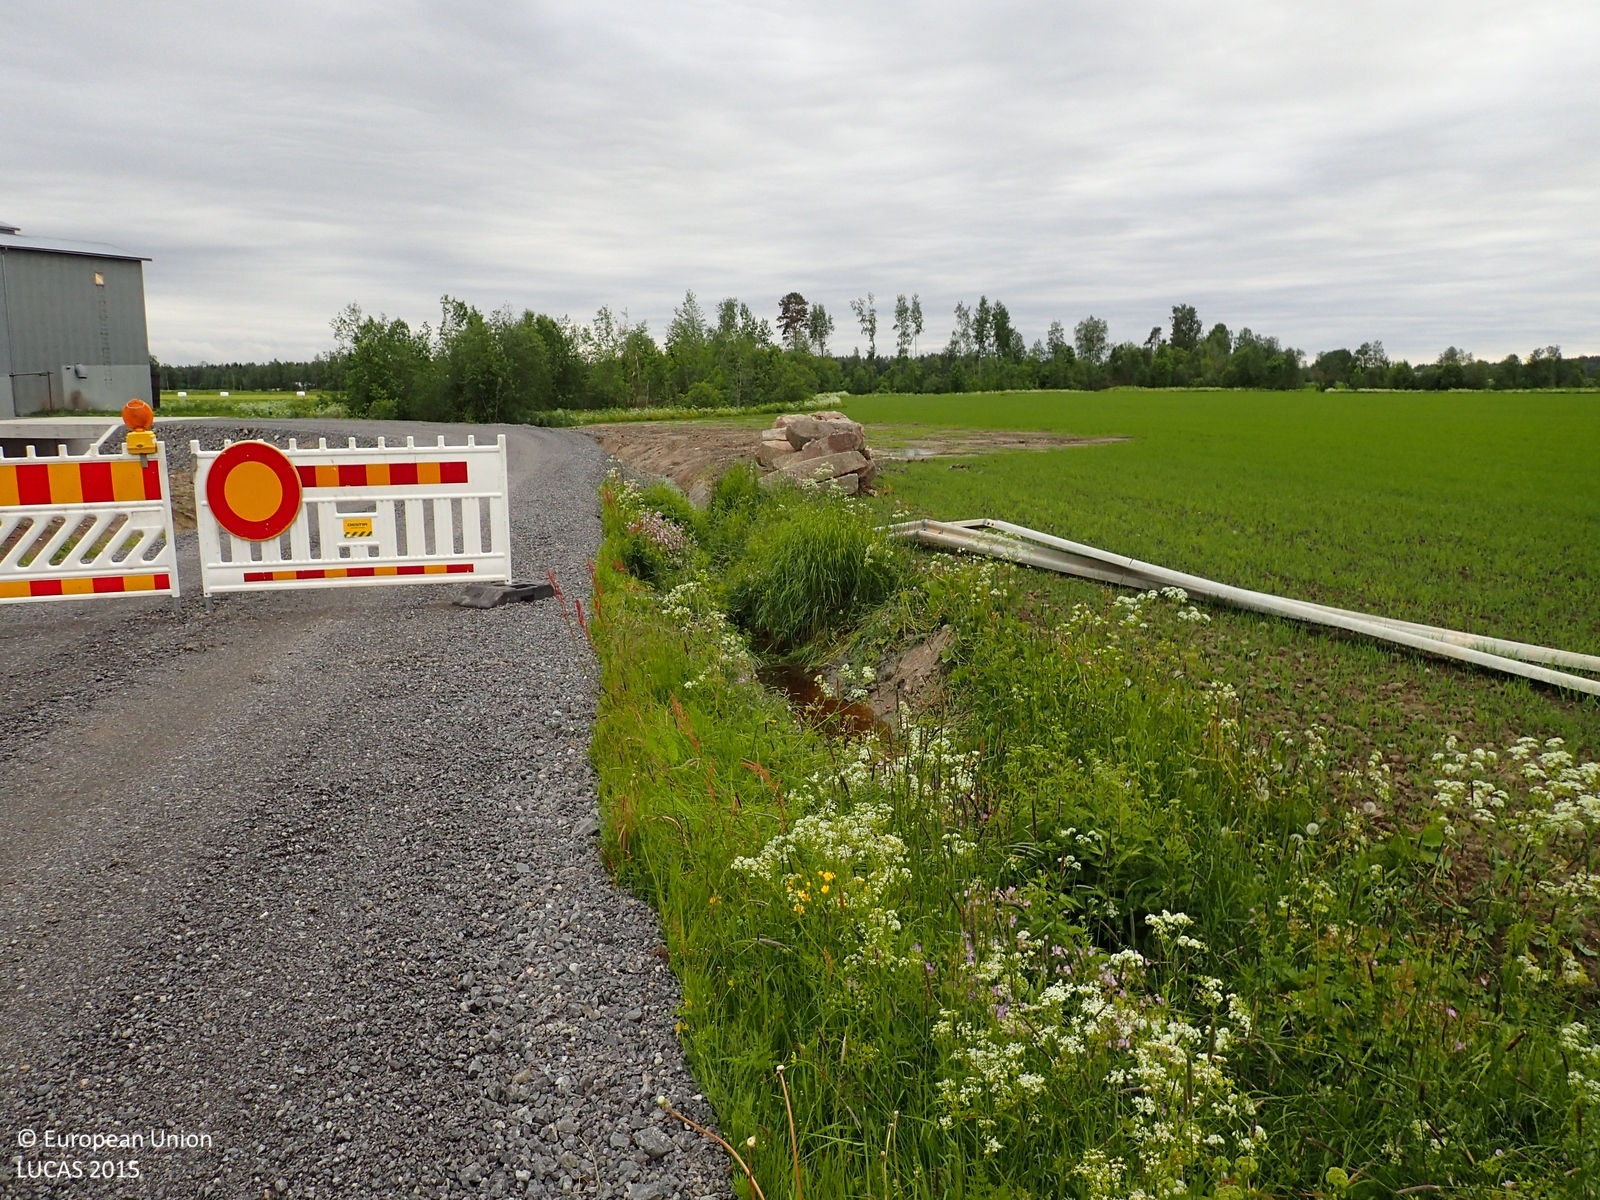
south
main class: Cropland
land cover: Barley
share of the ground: > 75 %
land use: Agriculture (excluding fallow land and kitchen gardens)
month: June
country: FI
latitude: 62.3292
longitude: 21.5689
